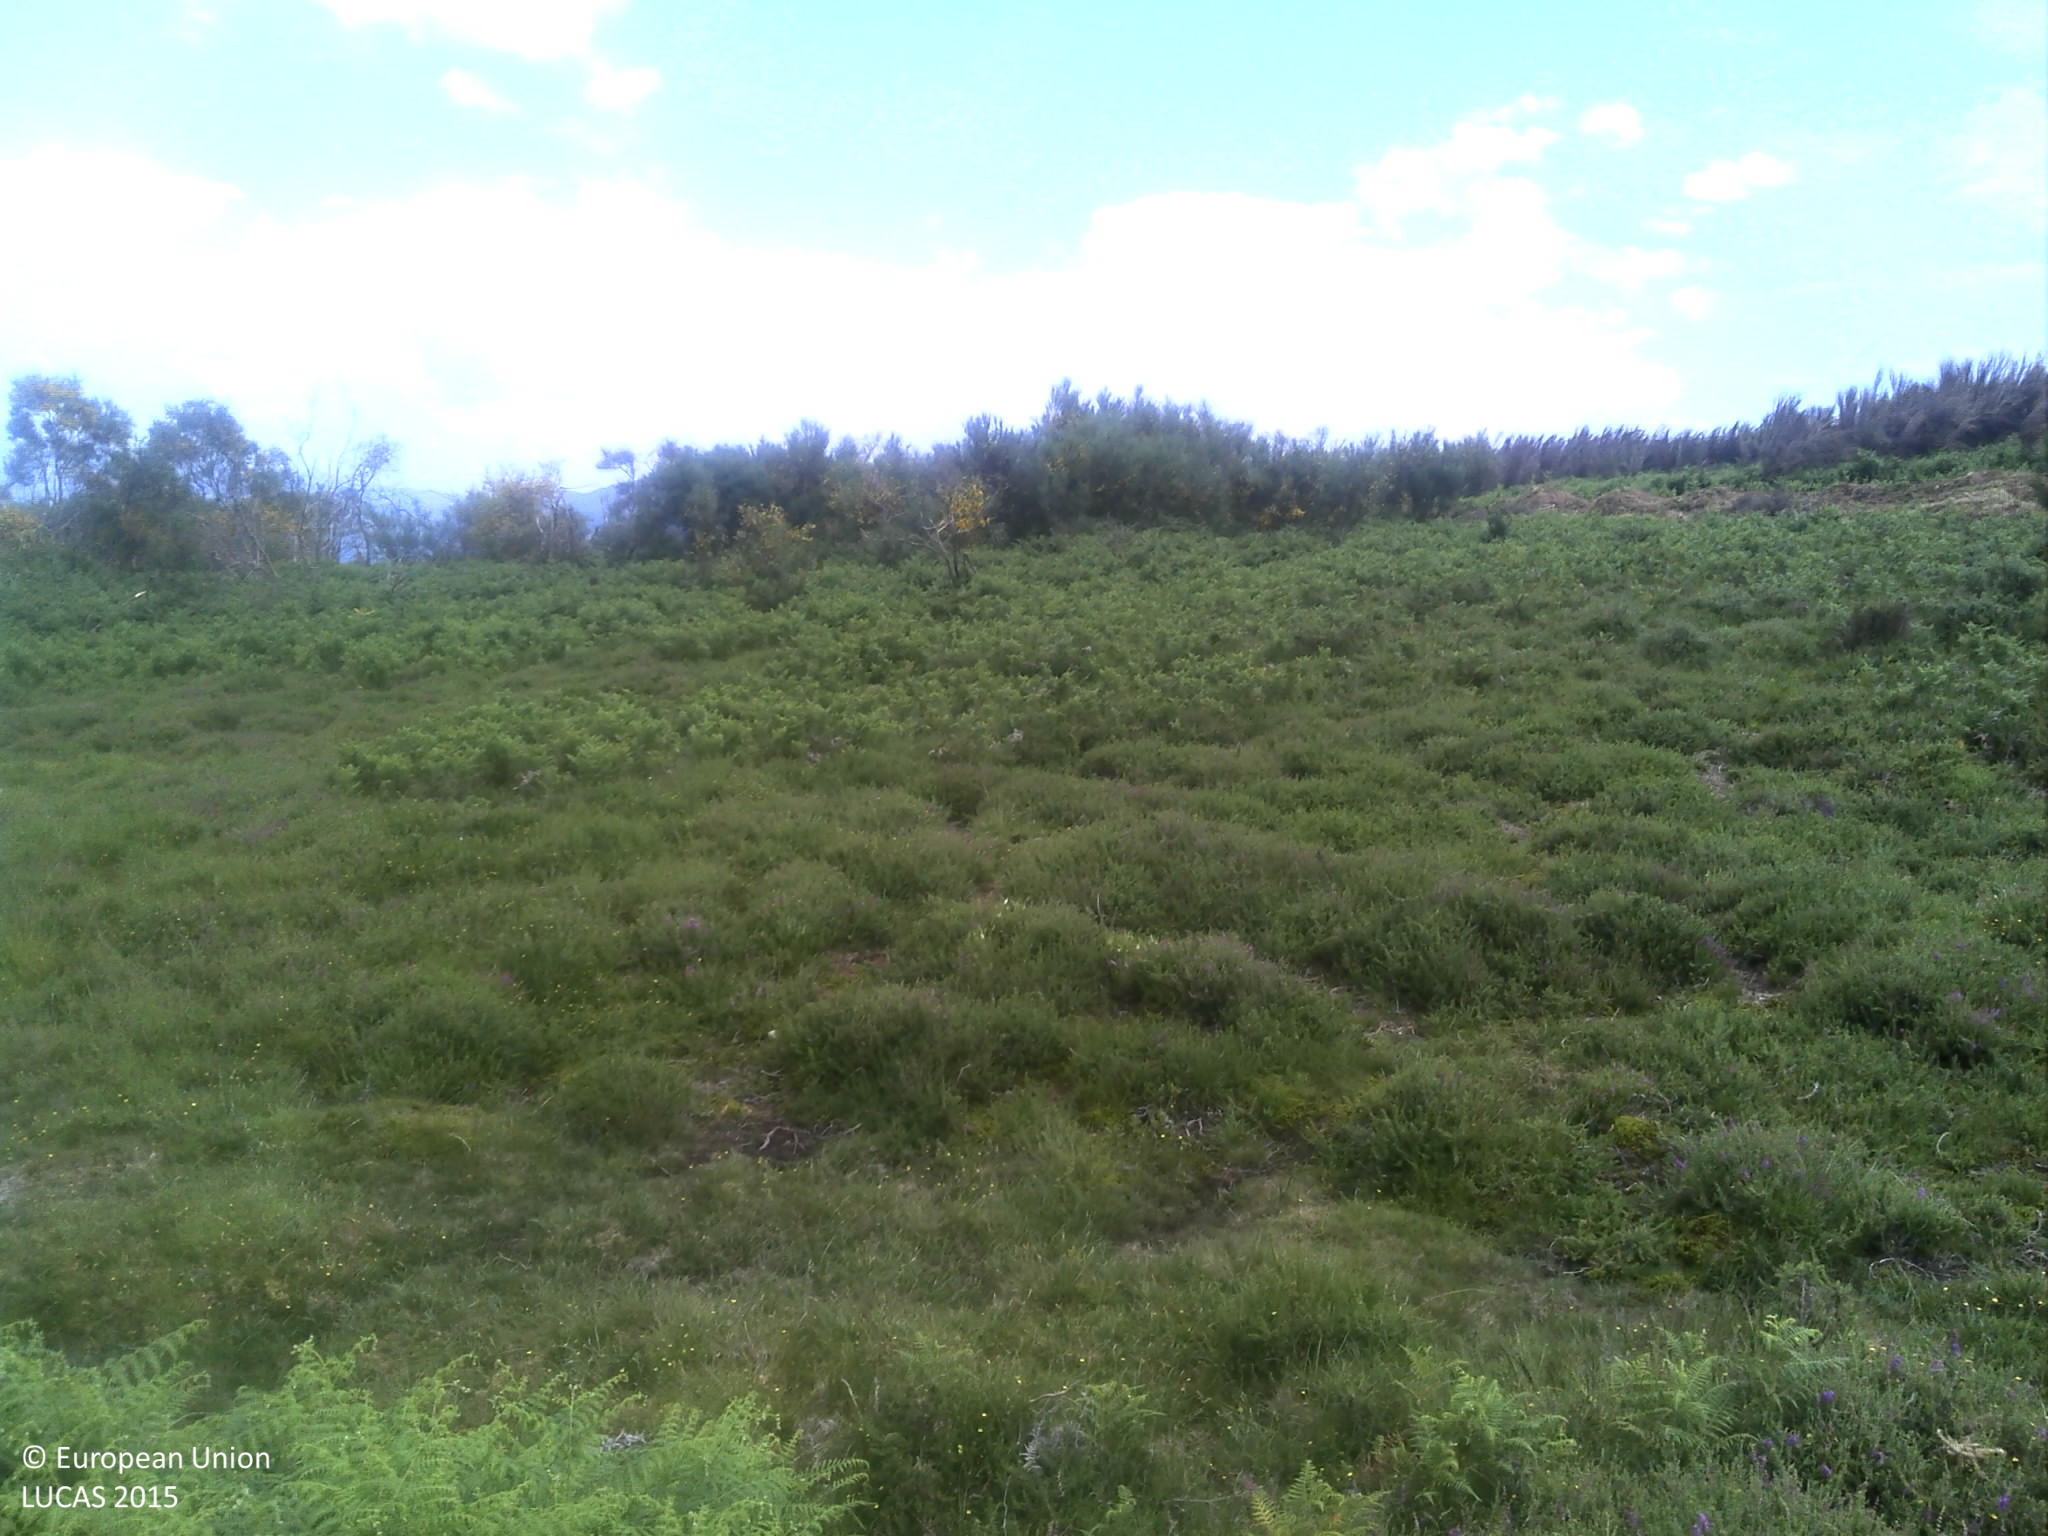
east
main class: Shrubland
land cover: Shrubland without tree cover
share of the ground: > 75 %
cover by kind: shrubs 60 %, herbaceous plants 35 %, unconsolidated bare surface 5 %
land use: Agriculture (excluding fallow land and kitchen gardens)
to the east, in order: Shrubland without tree cover; Grass margins; Tracks; Grass margins; Shrubland without tree cover
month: June
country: PT
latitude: 41.7328
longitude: -8.3694
